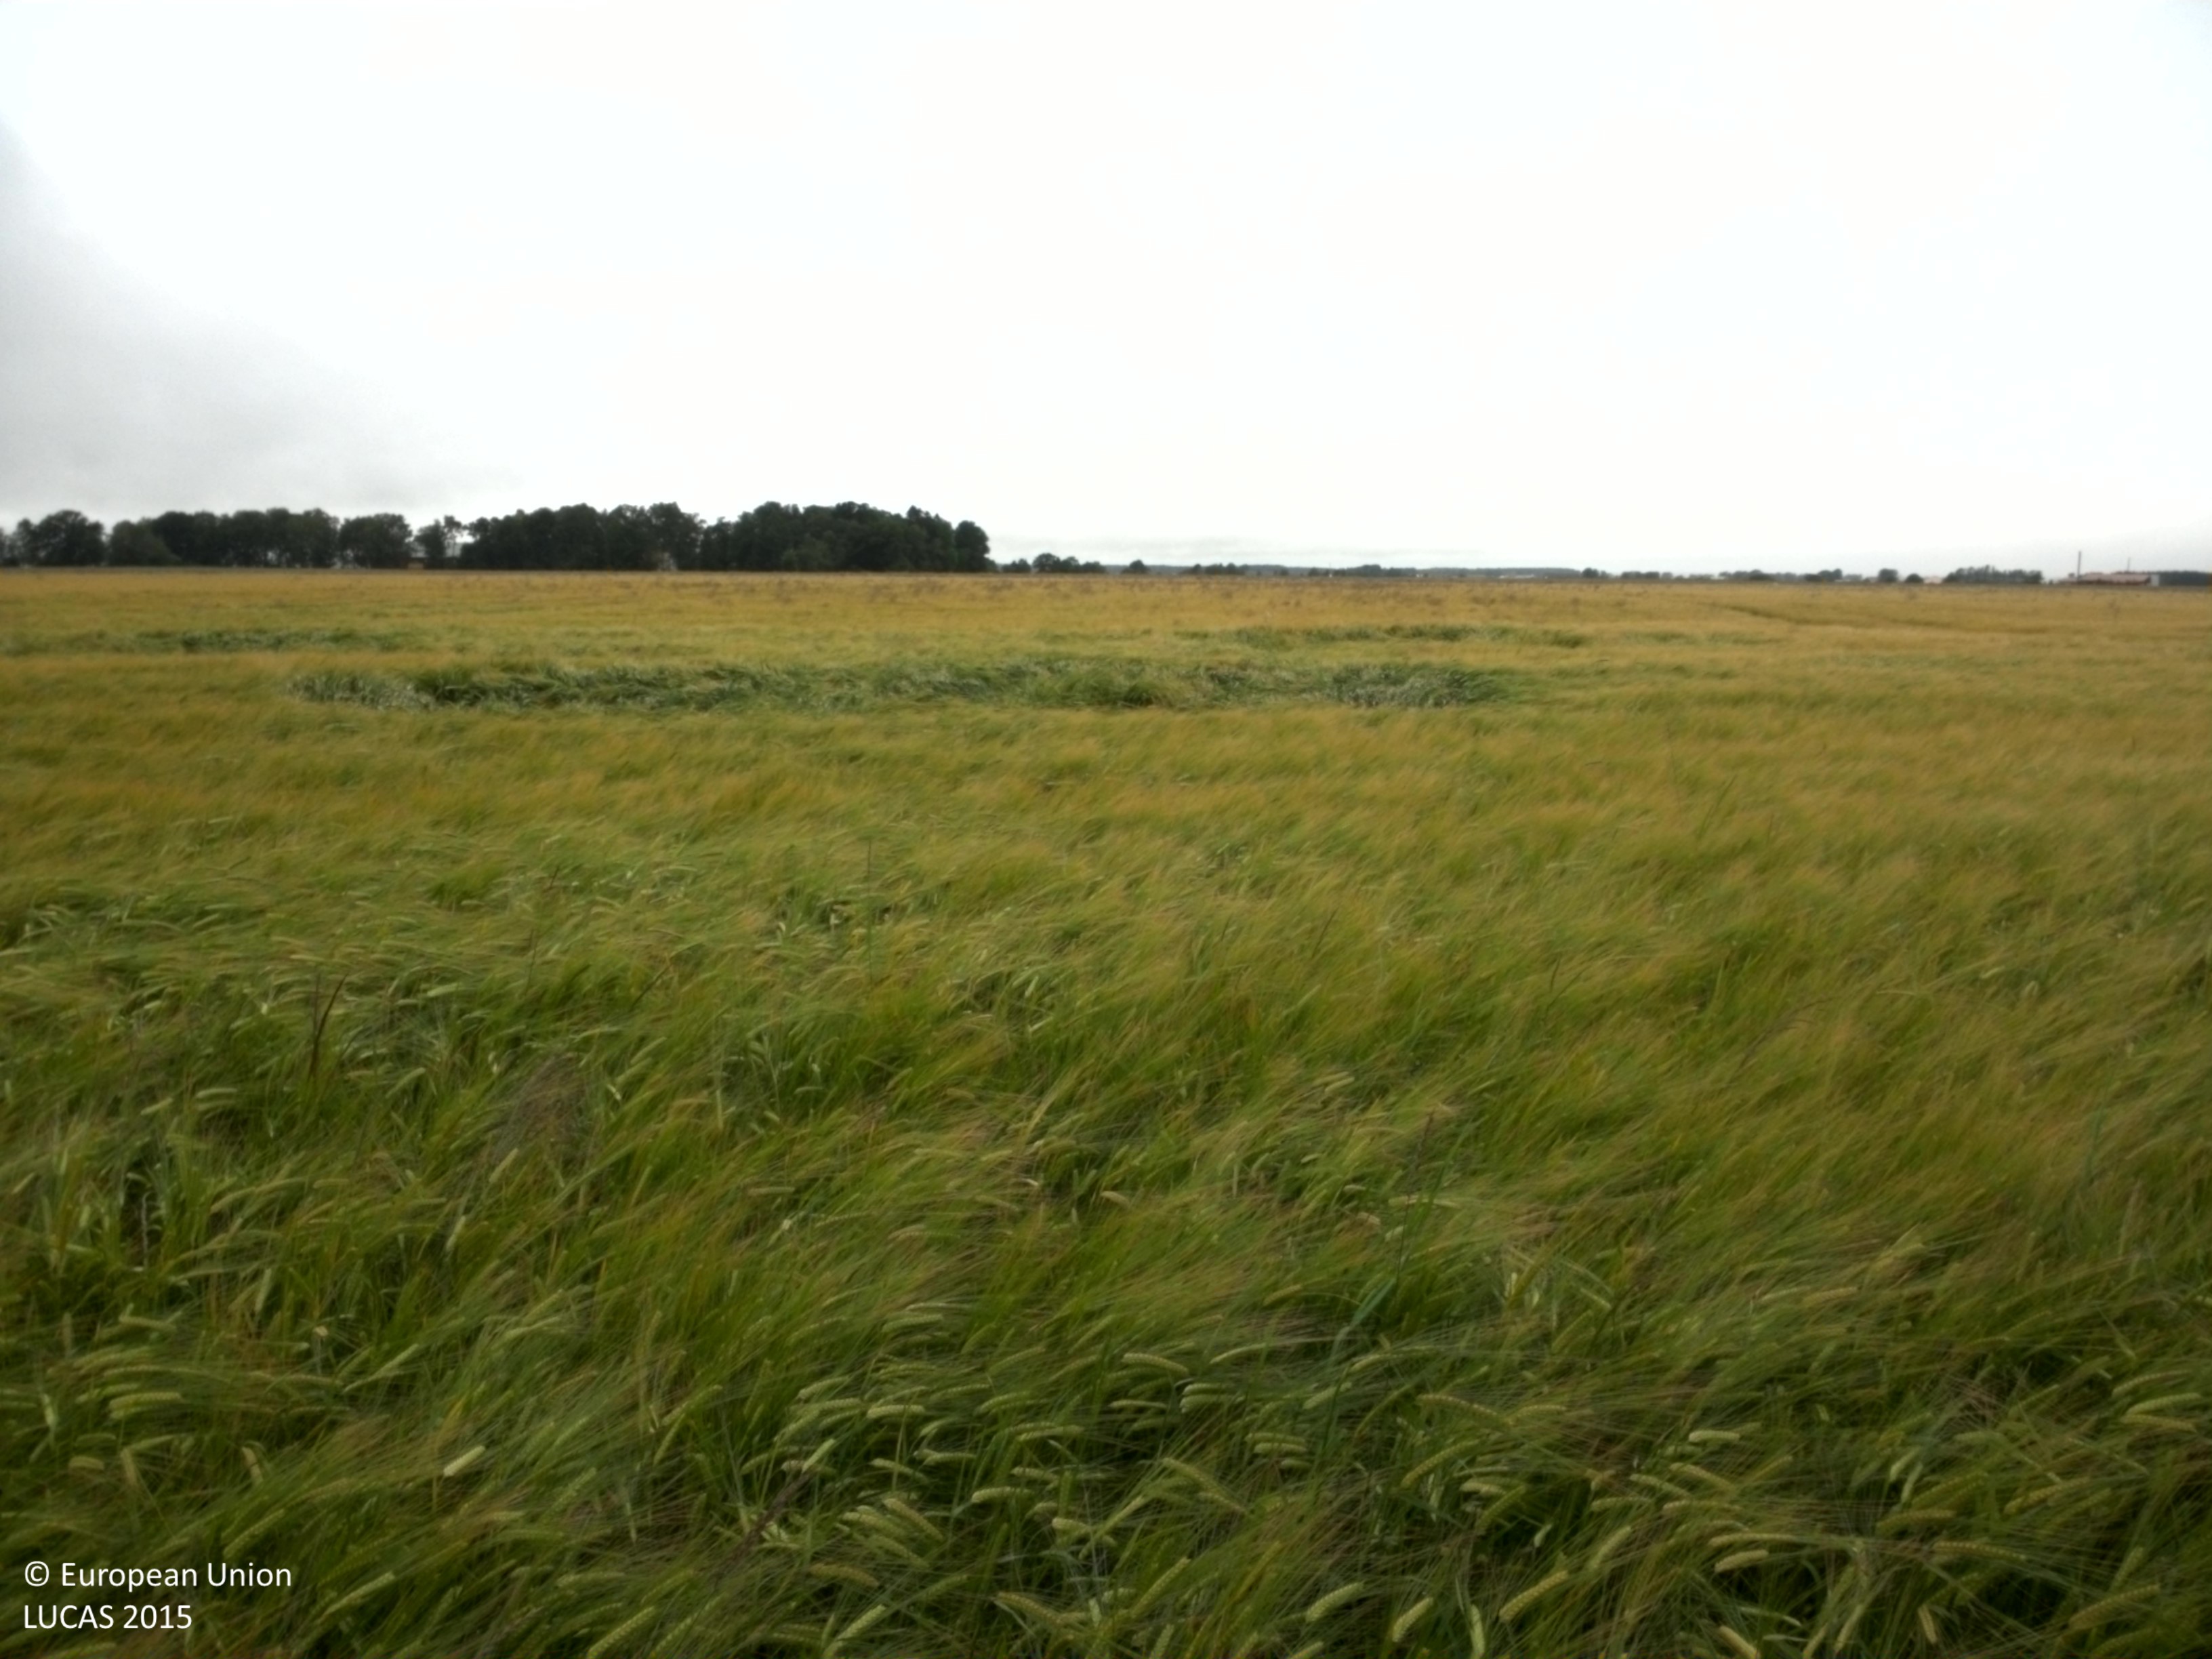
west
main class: Cropland
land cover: Barley
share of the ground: > 75 %
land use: Agriculture (excluding fallow land and kitchen gardens)
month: July
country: SE
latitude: 58.4327
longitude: 13.2311
